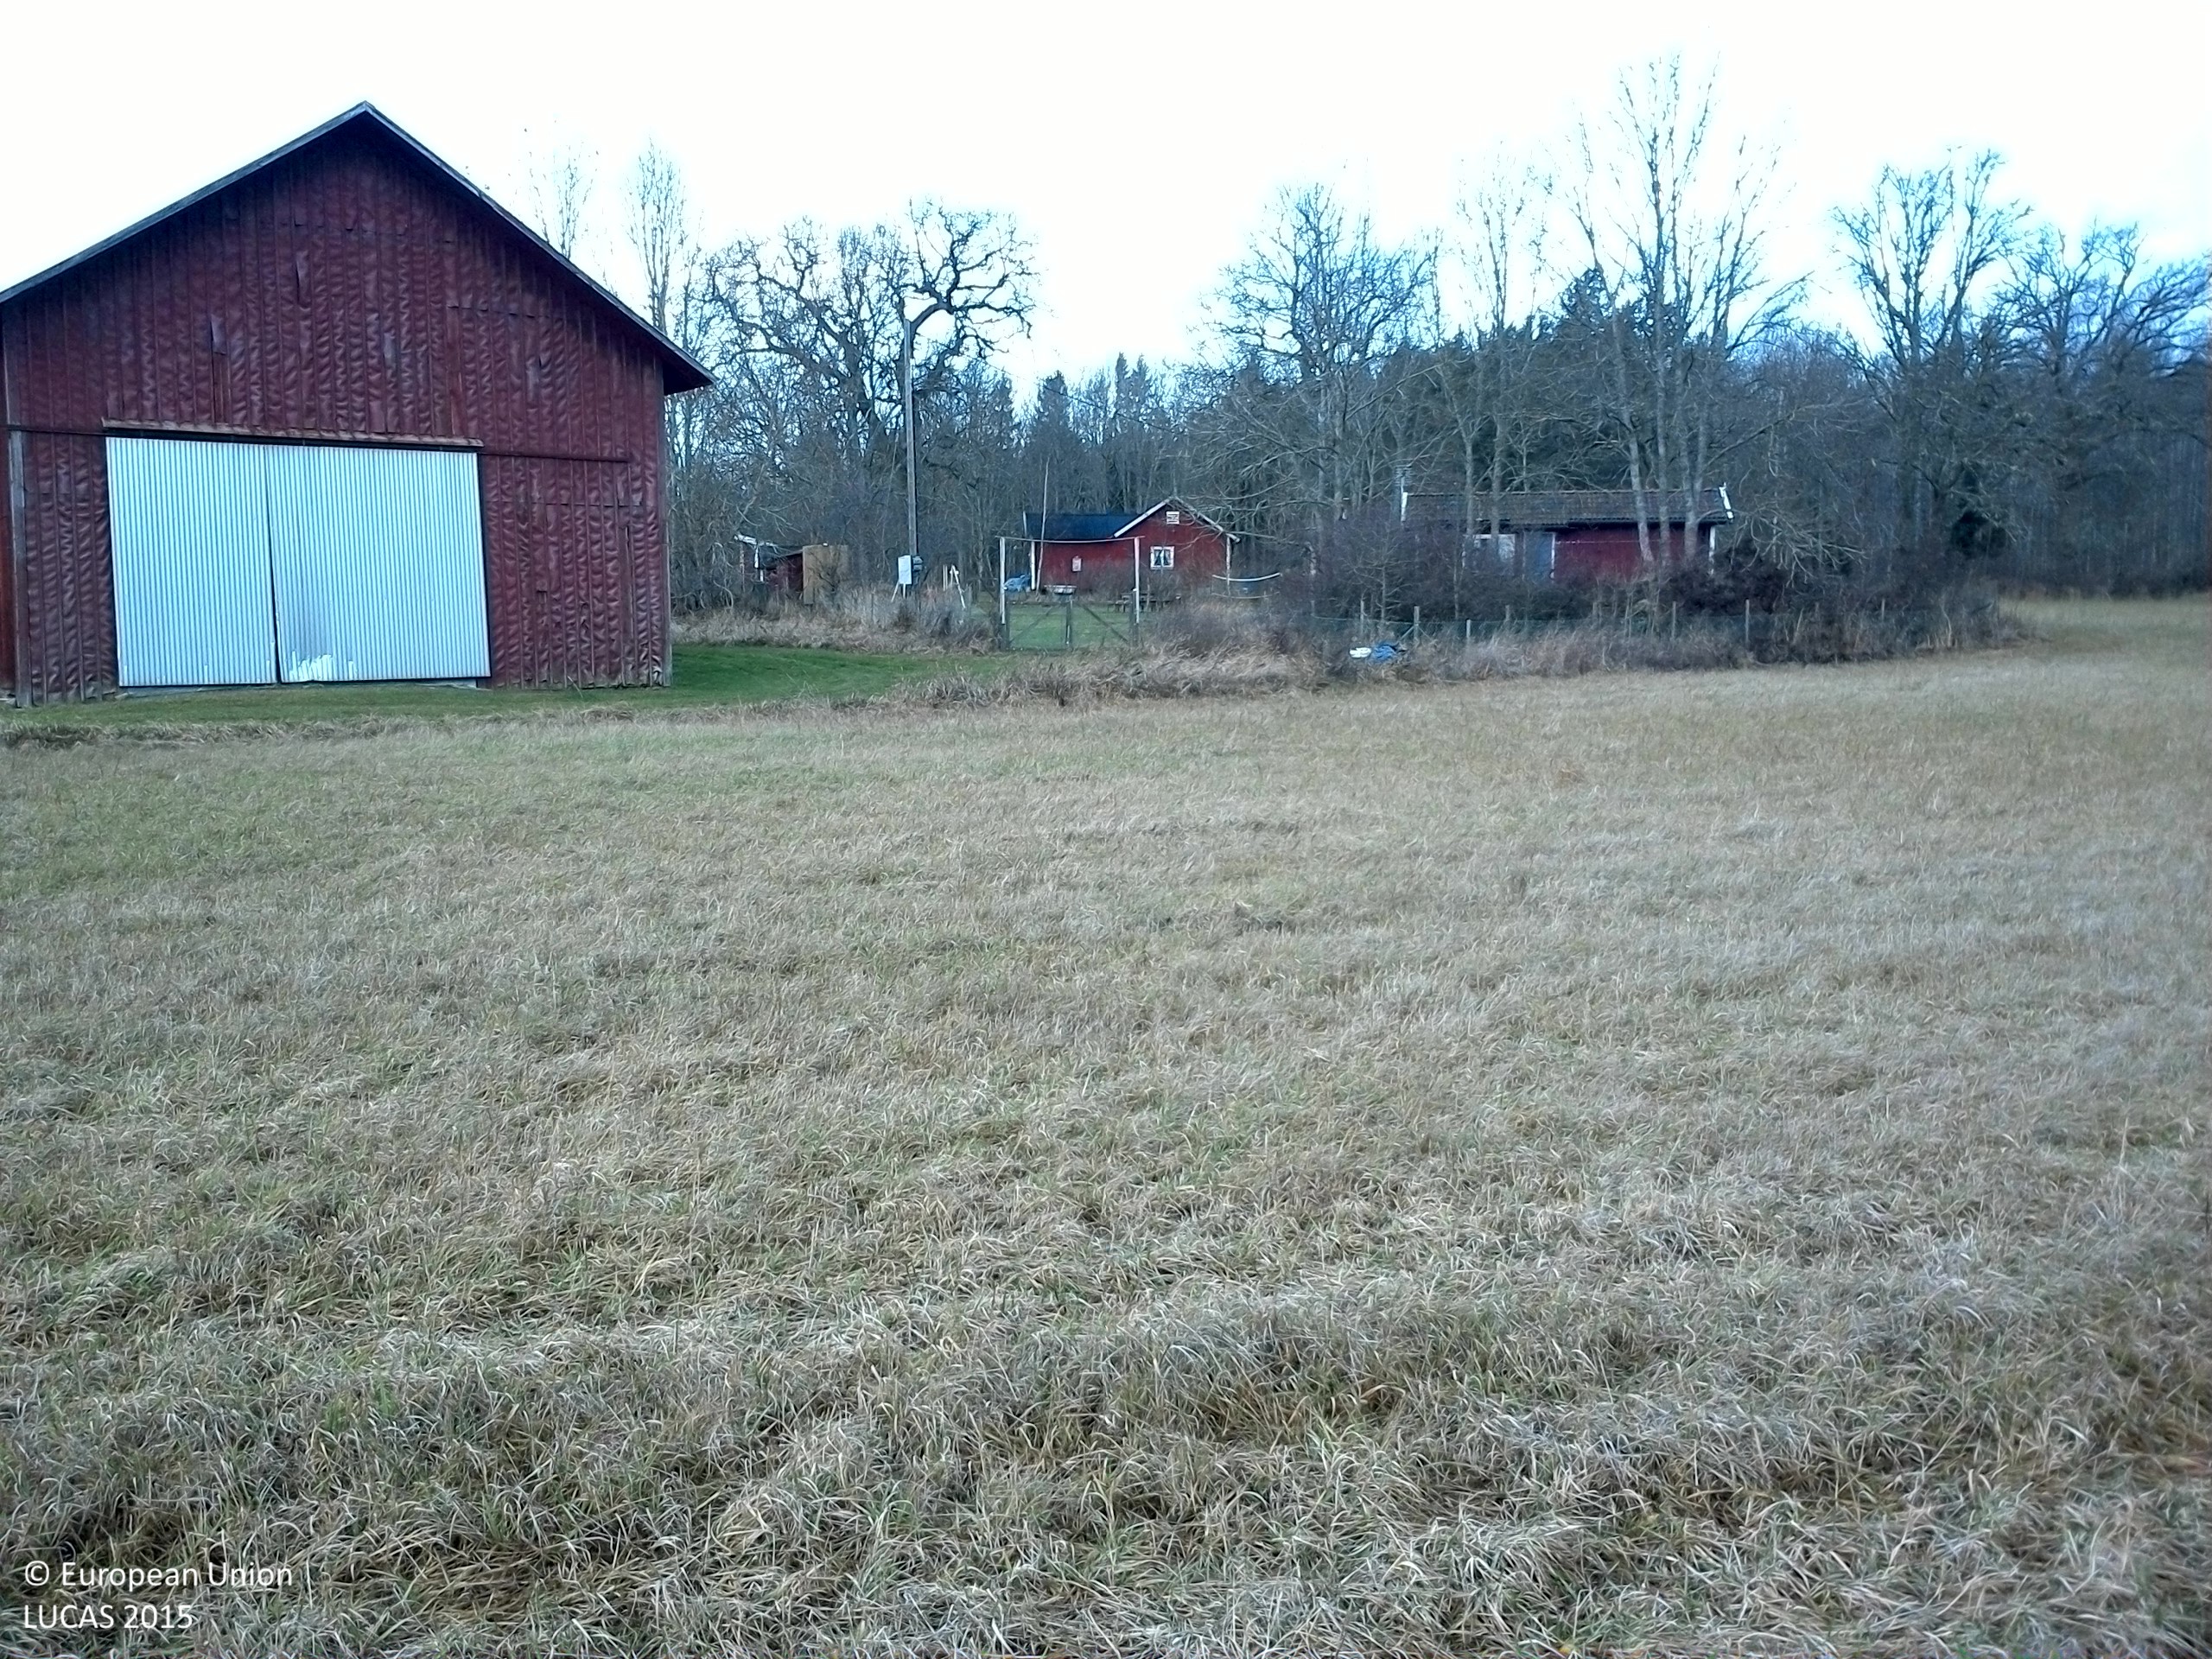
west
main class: Grassland
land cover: Grassland without tree/shrub cover
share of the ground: > 75 %
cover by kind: herbaceous plants 100 %
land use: Agriculture (excluding fallow land and kitchen gardens)
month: December
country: SE
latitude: 59.4340
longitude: 16.8870
